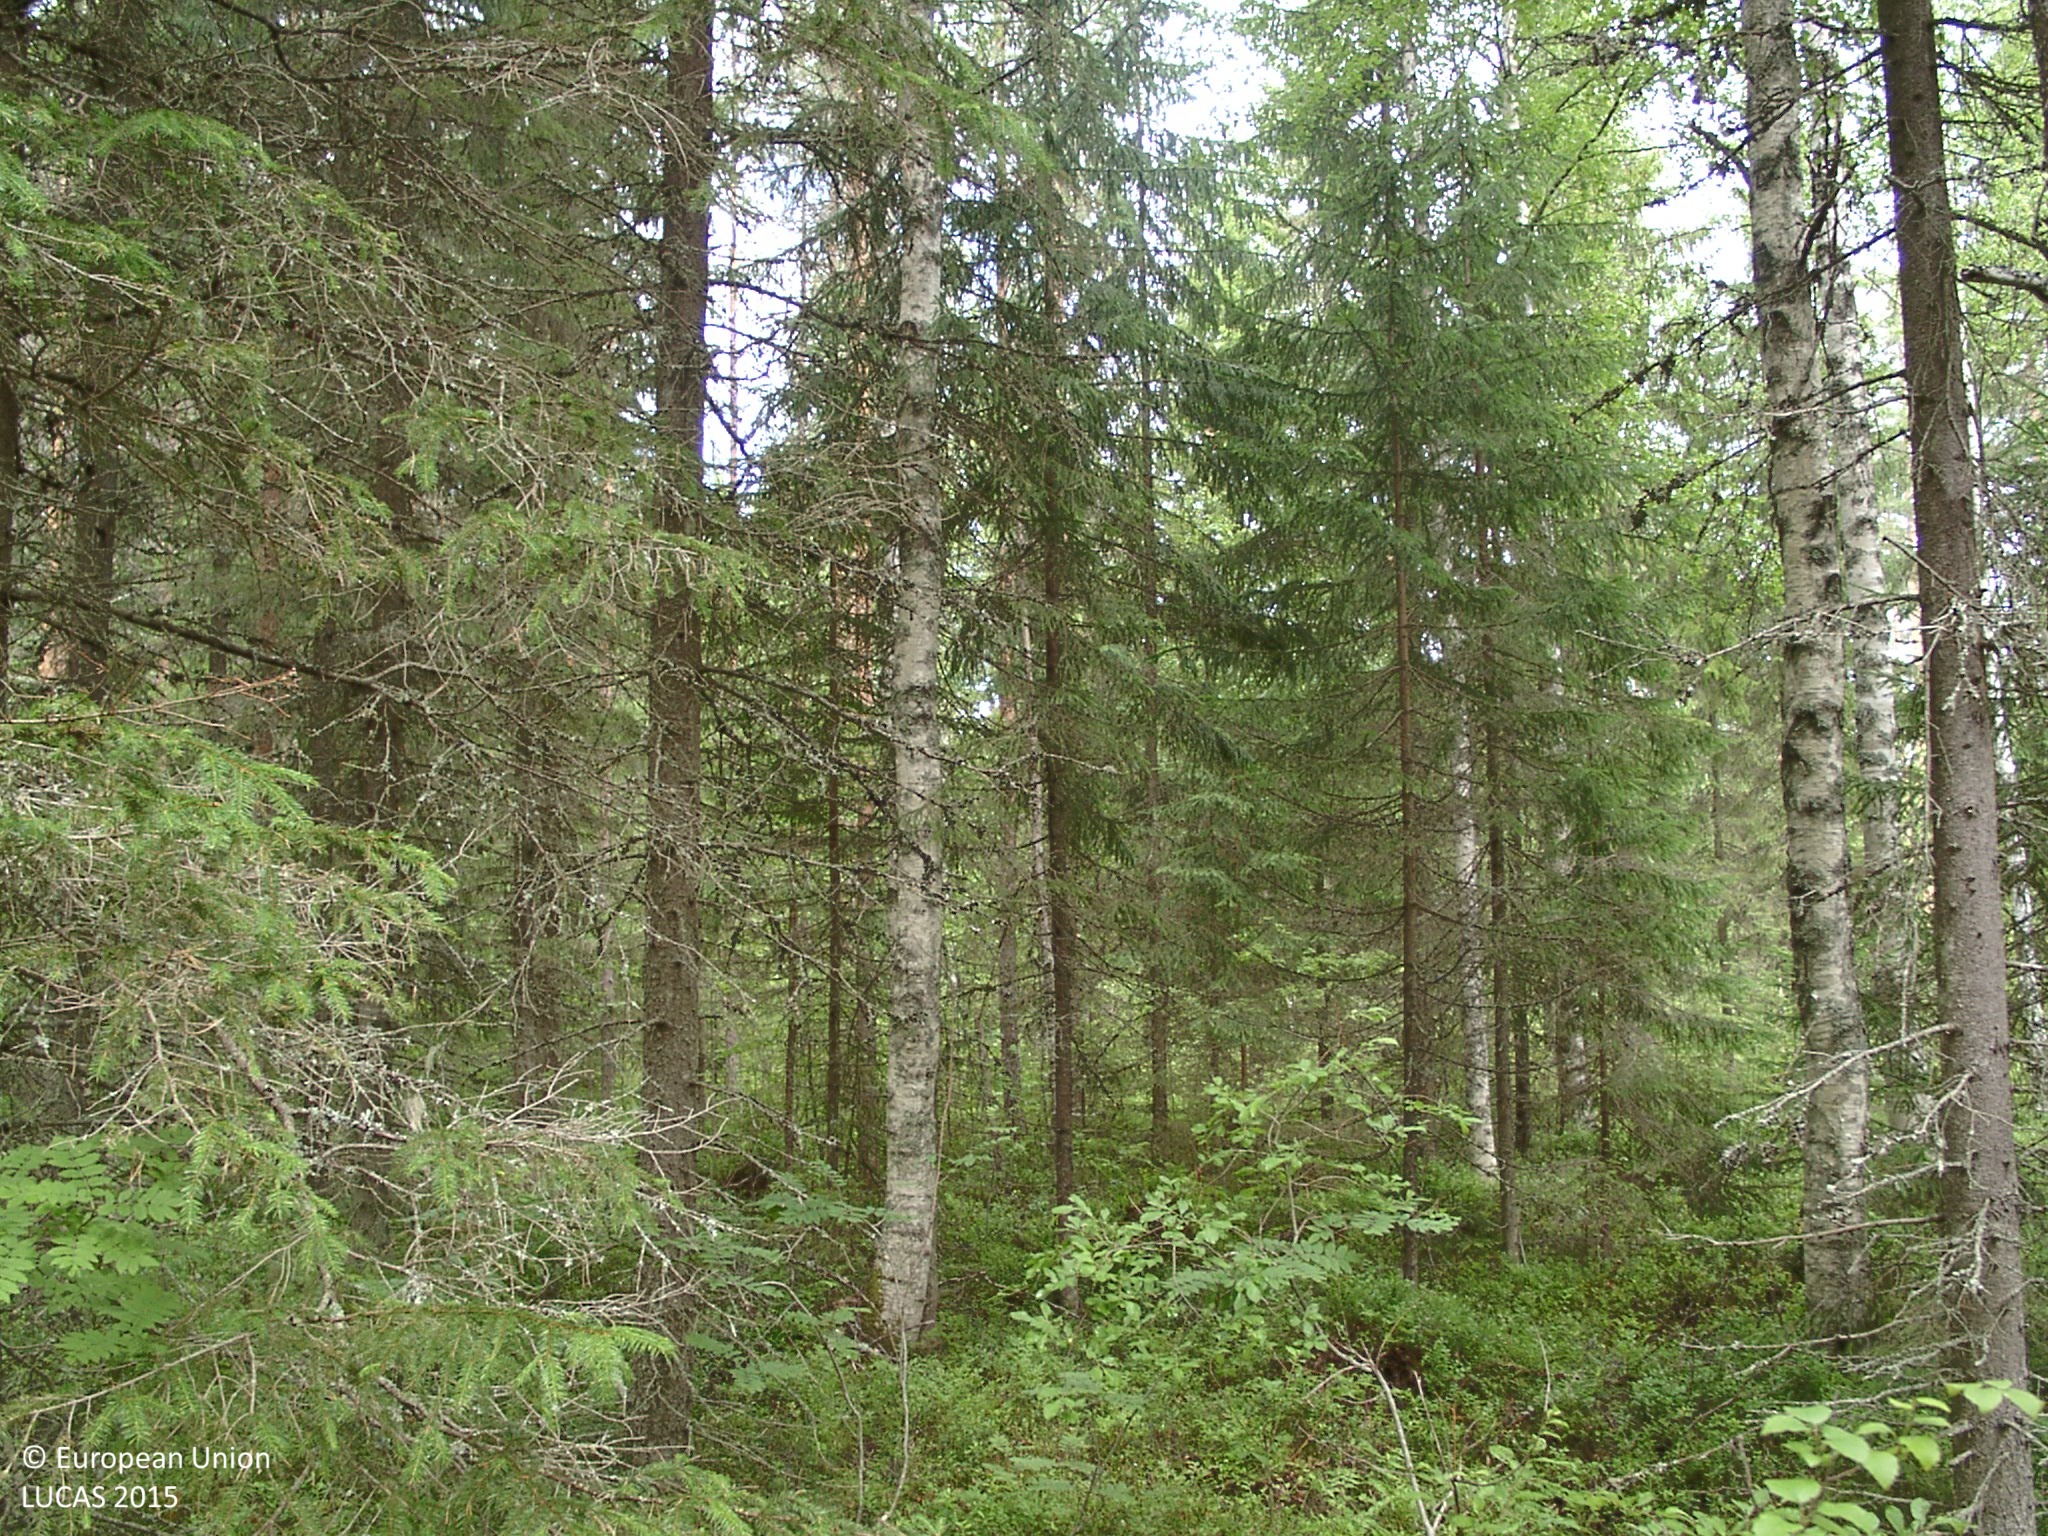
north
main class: Woodland
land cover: Other mixed woodland
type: boreal forest
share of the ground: 50 - 75 %
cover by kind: coniferous forest trees 45 %, broadleaved forest trees 25 %, shrubs 20 %, lichens and mosses 10 %
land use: Forestry
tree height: > 5 m
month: July
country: FI
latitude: 61.6456
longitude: 24.8847
